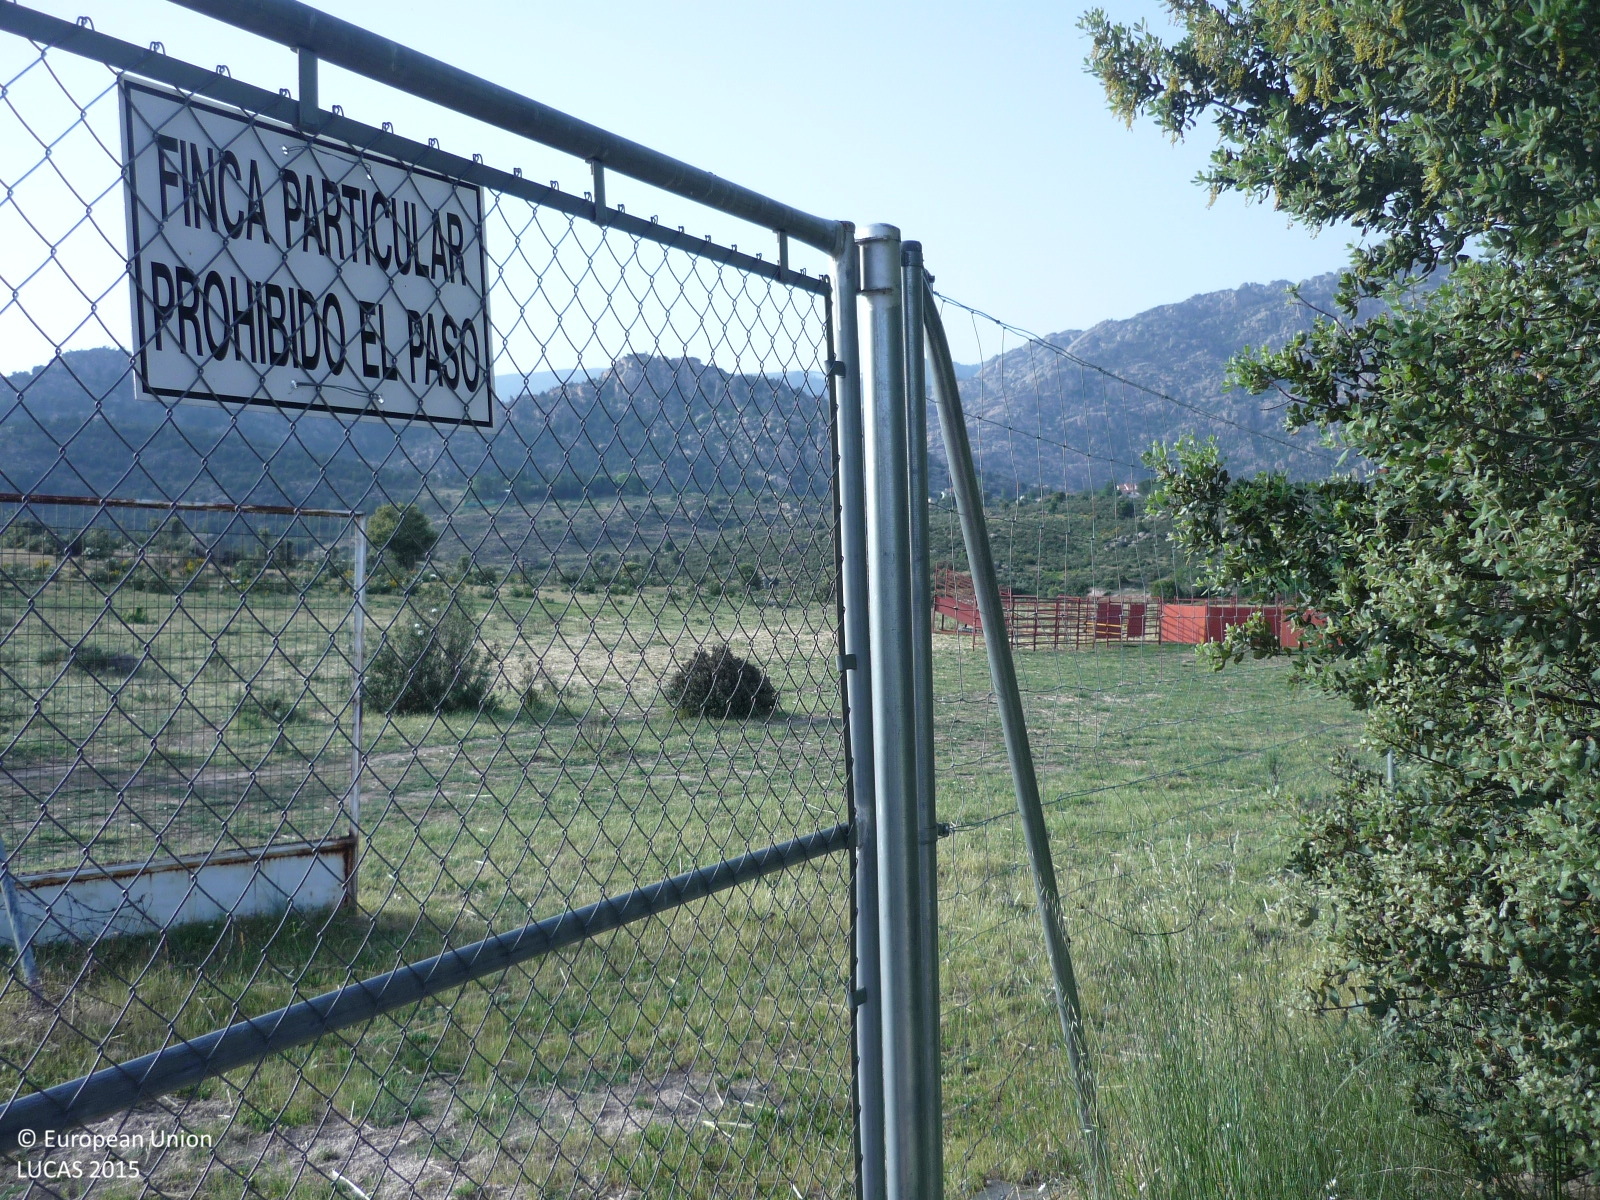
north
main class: Grassland
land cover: Grassland with sparse tree/shrub cover
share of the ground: > 75 %
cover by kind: herbaceous plants 85 %, shrubs 10 %, broadleaved forest trees 5 %
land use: Agriculture (excluding fallow land and kitchen gardens)
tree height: < 5 m
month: May
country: ES
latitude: 40.7224
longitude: -3.8837
